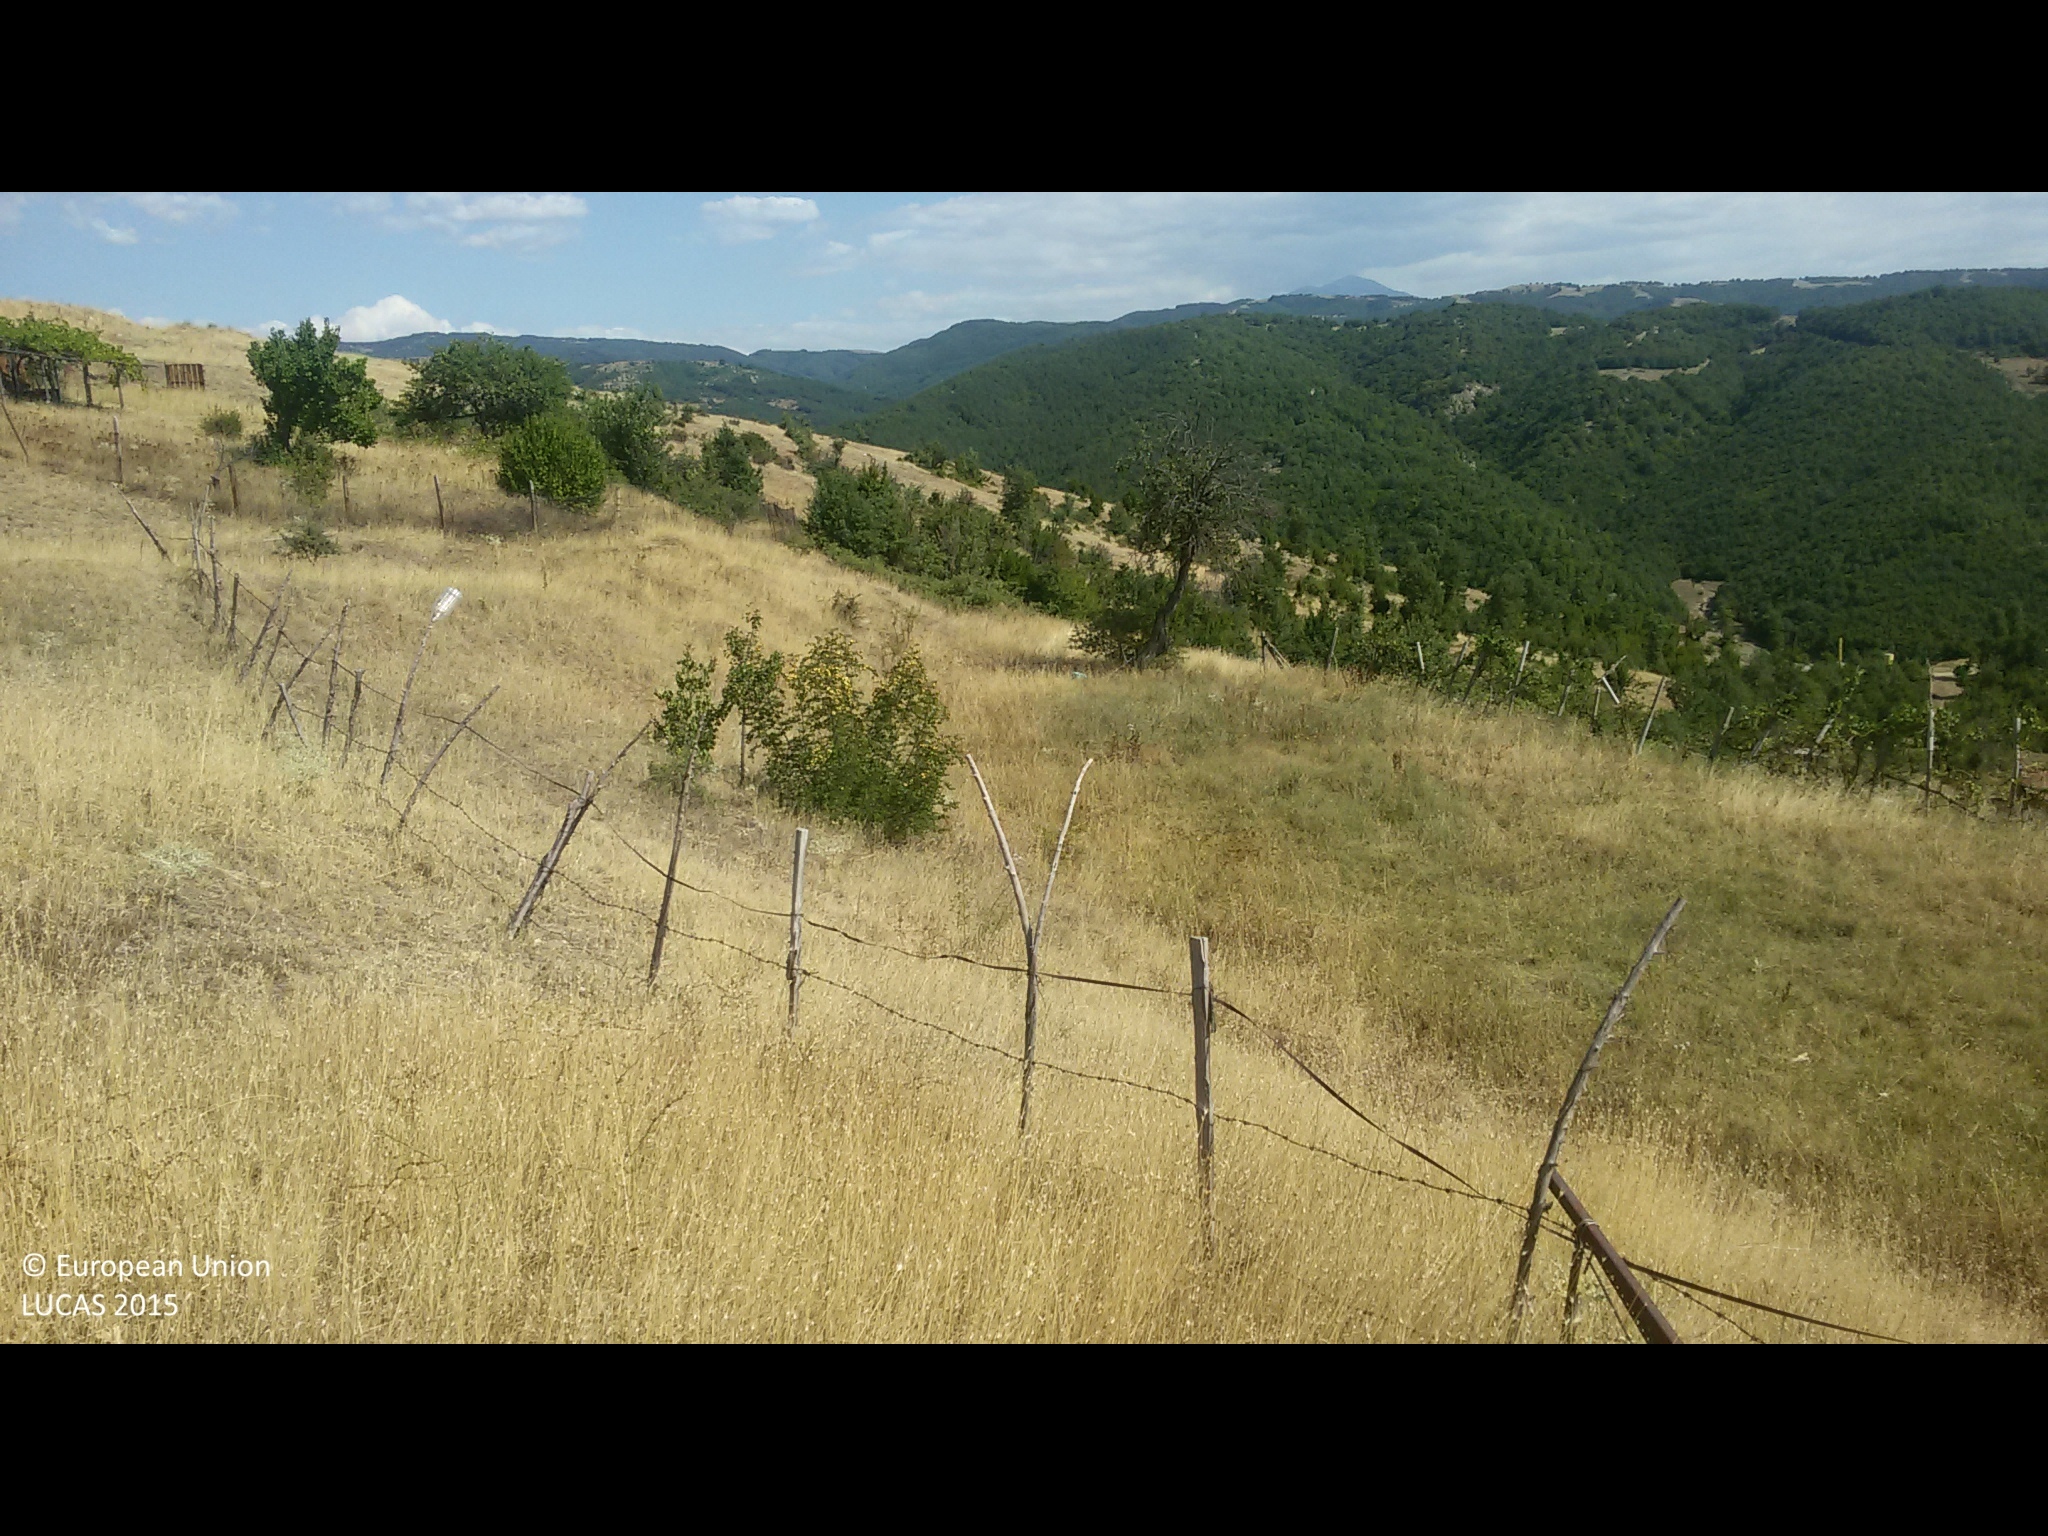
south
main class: Grassland
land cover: Grassland without tree/shrub cover
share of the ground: > 75 %
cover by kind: herbaceous plants 95 %, shrubs 5 %
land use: Agriculture (excluding fallow land and kitchen gardens)
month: August
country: BG
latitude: 41.9972
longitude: 23.1228
